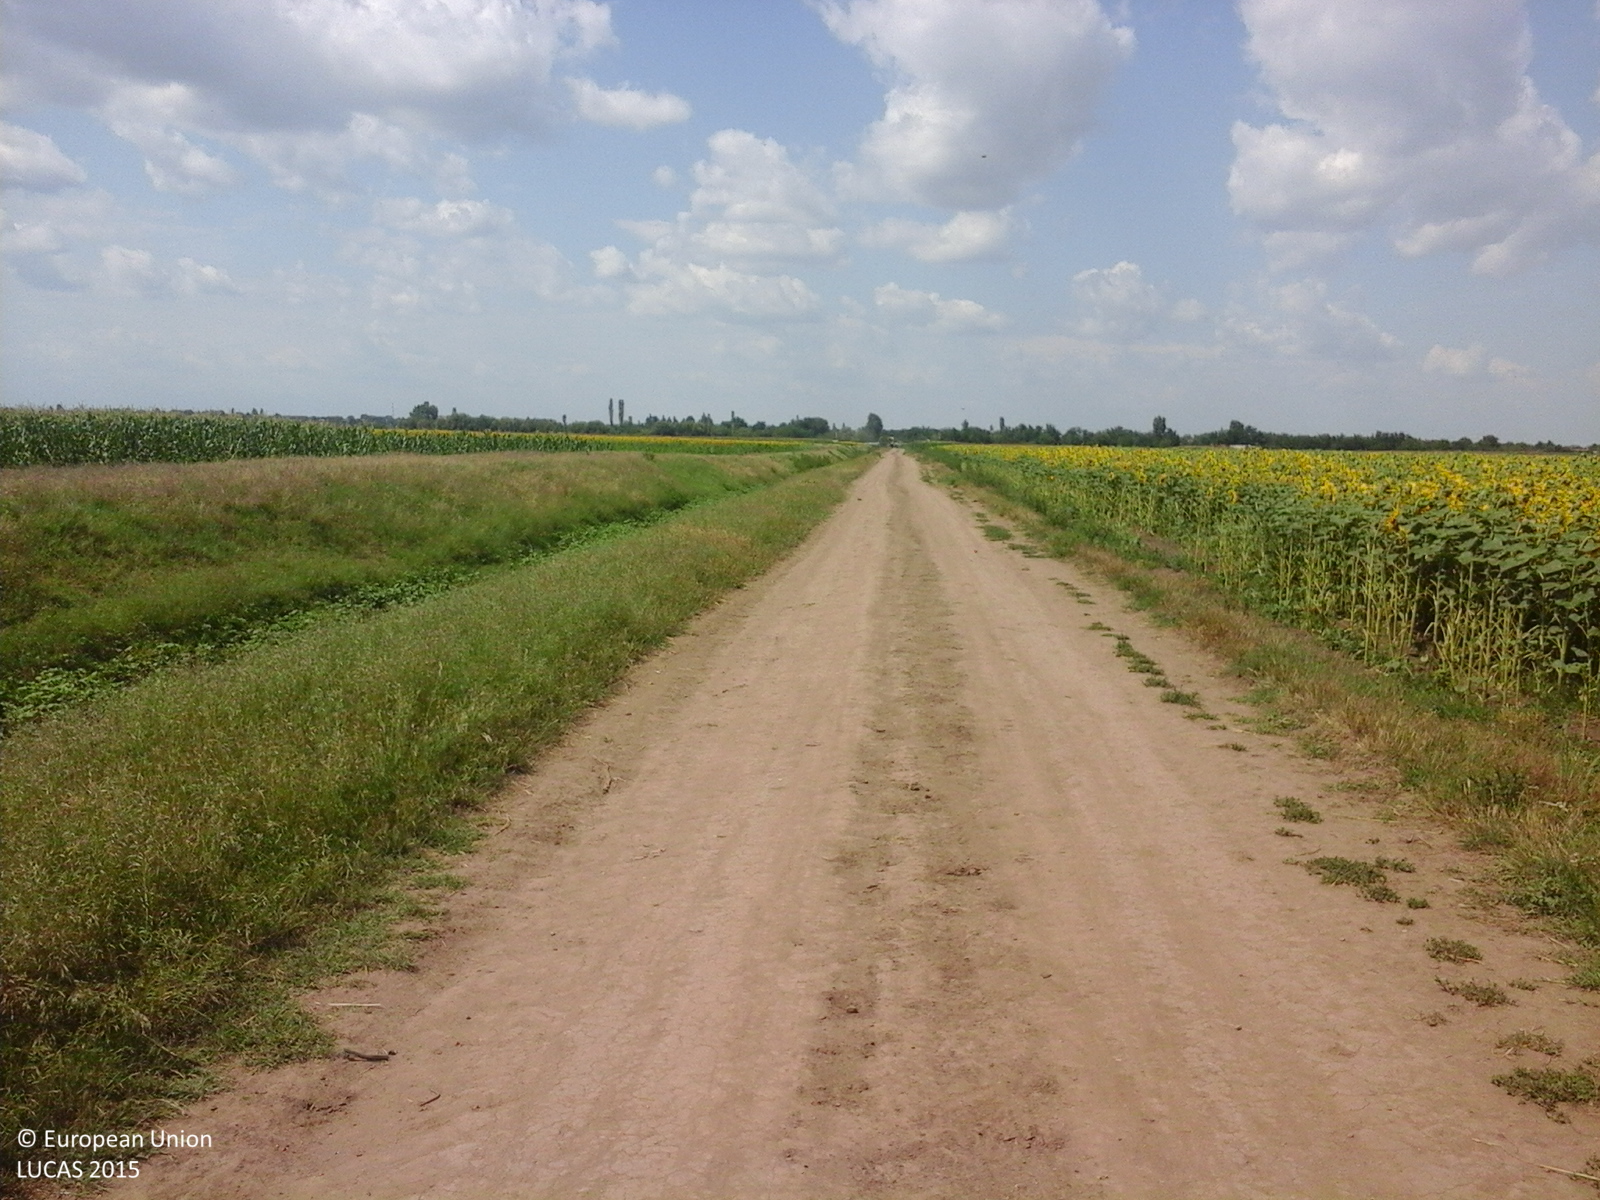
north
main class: Cropland
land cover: Sunflower
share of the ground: > 75 %
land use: Agriculture (excluding fallow land and kitchen gardens)
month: July
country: RO
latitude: 43.8230
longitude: 24.3486
